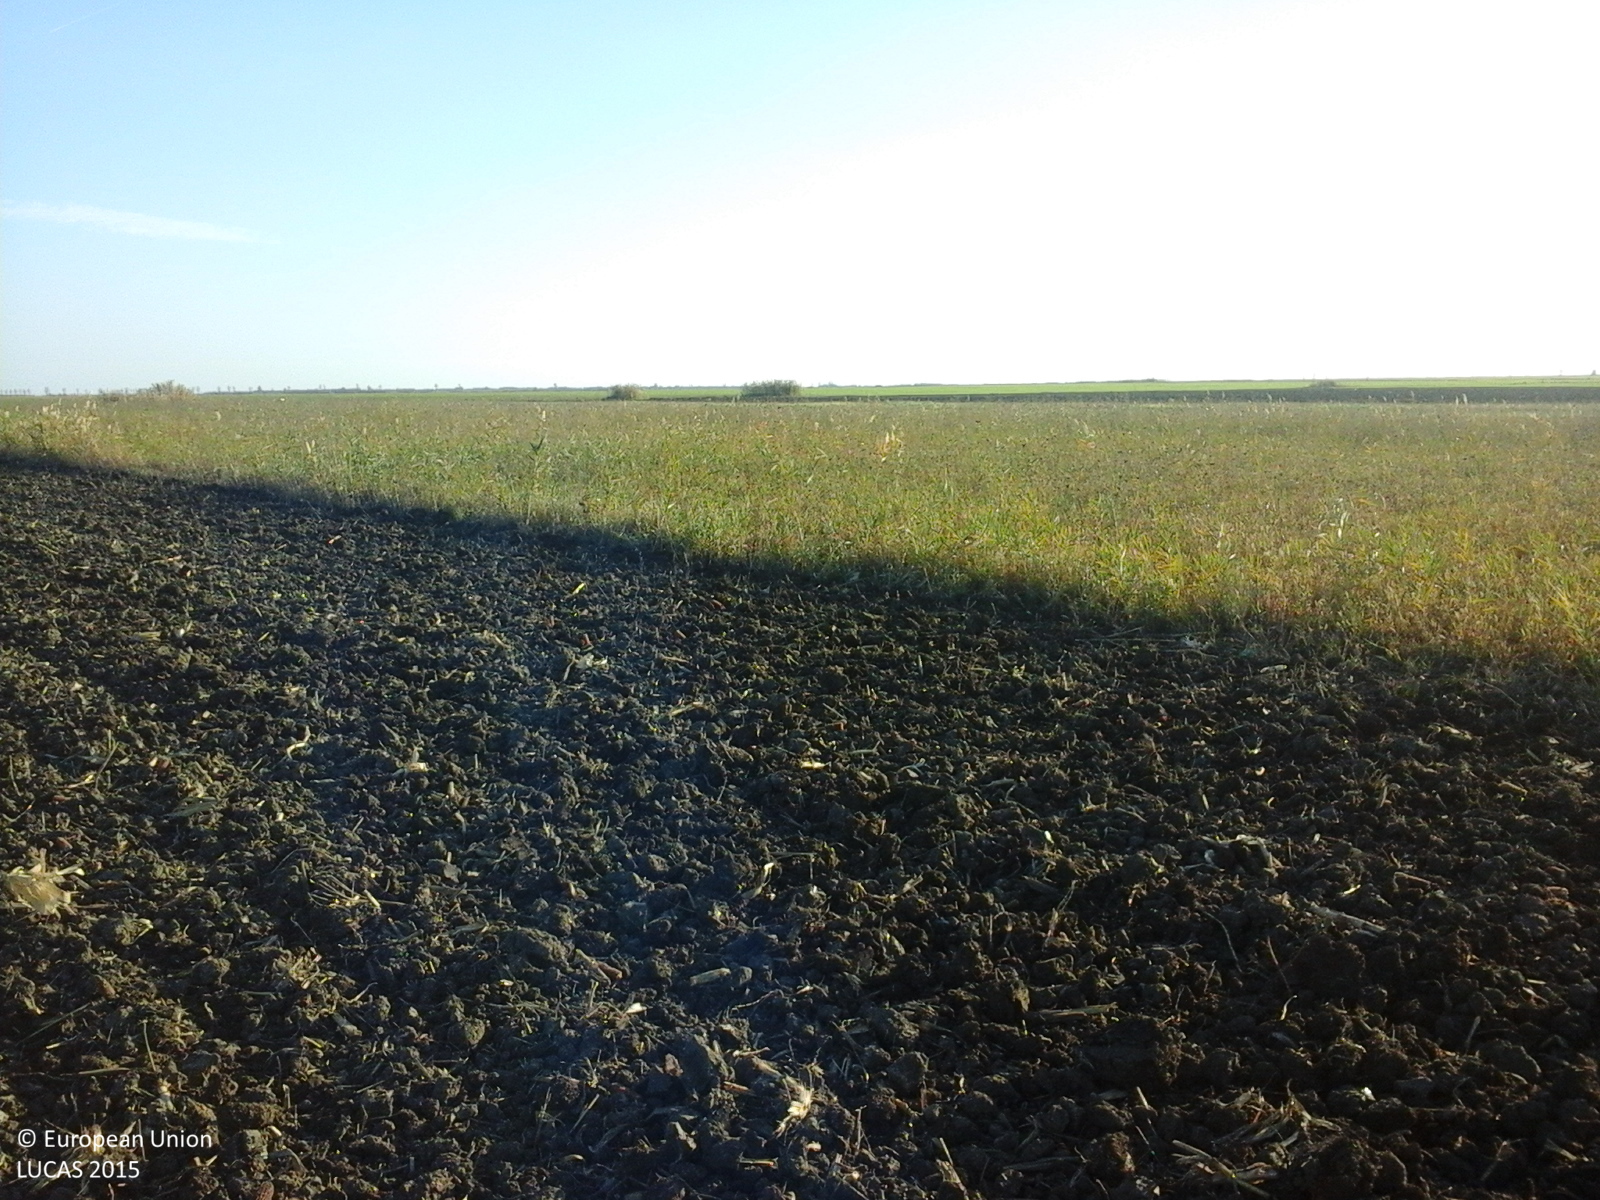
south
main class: Cropland
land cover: Maize
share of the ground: < 10 %
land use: Agriculture (excluding fallow land and kitchen gardens)
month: October
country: RO
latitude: 45.4110
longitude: 27.4915
